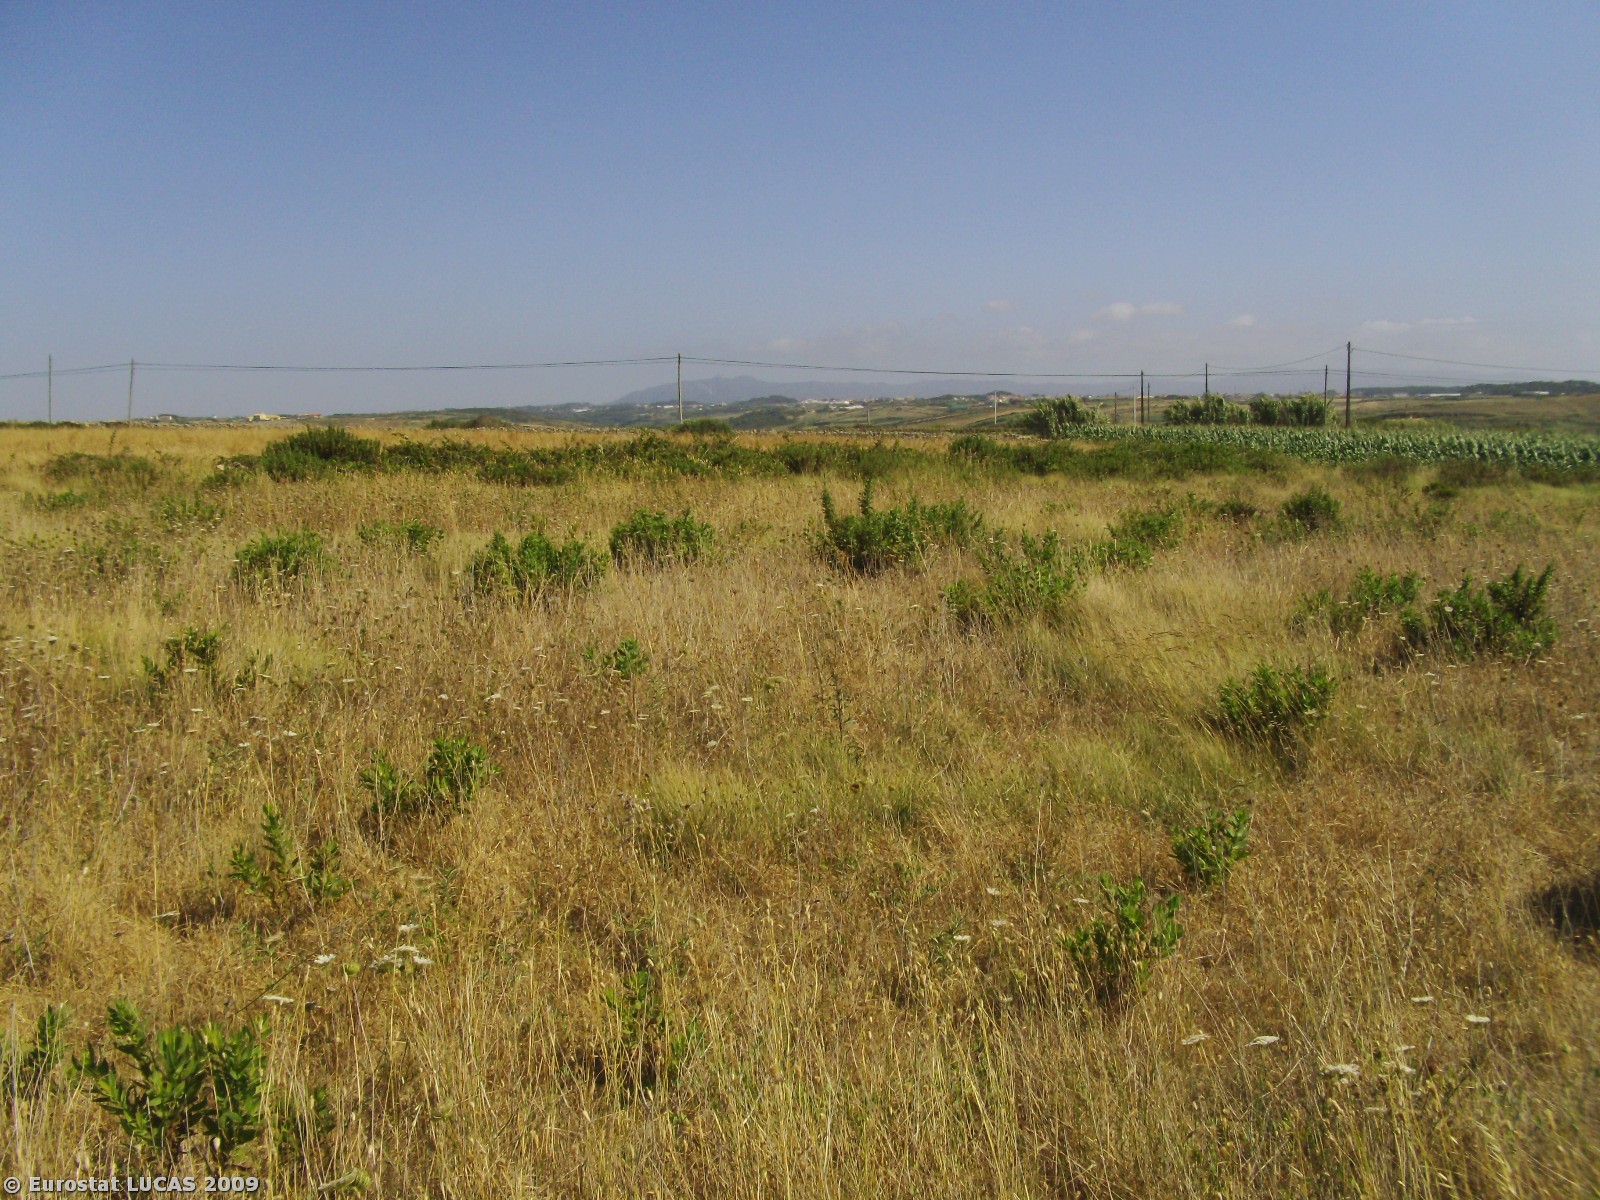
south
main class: Grassland
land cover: Spontaneously vegetated surfaces
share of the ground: > 75 %
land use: Fallow land
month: July
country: PT
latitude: 38.8984
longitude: -9.4234
